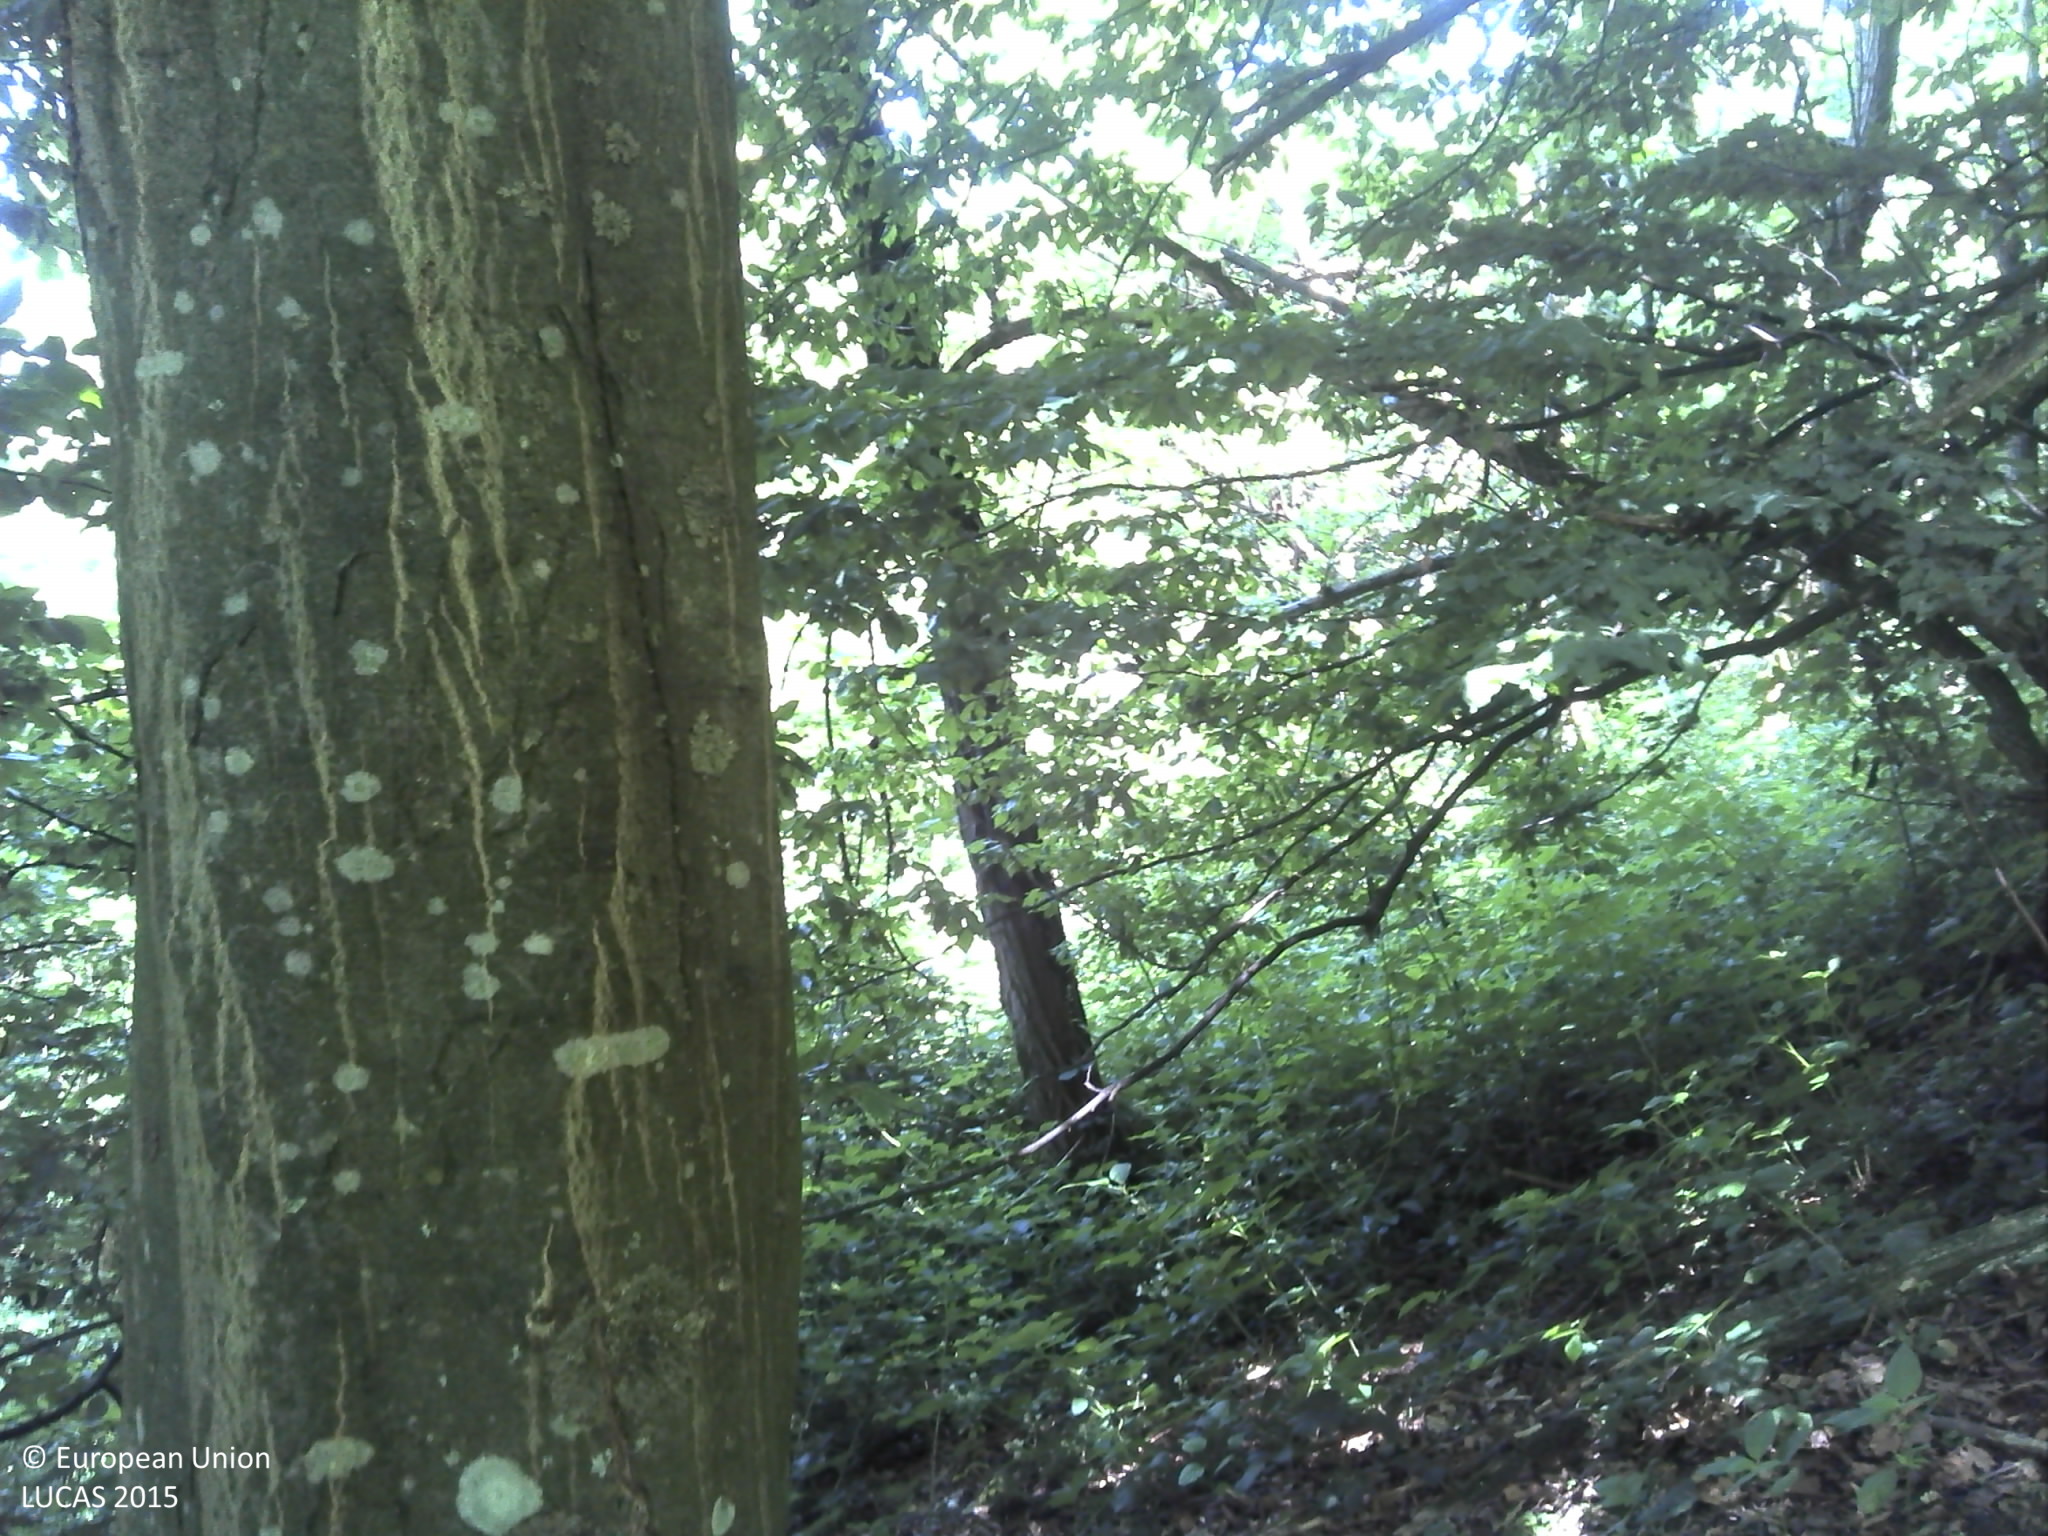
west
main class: Woodland
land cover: Broadleaved woodland
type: acidophilous oak and oak-birch forest
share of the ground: > 75 %
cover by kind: broadleaved forest trees 80 %, lichens and mosses 20 %
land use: Forestry
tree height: > 5 m
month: June
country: HR
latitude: 45.4676
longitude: 17.8176
